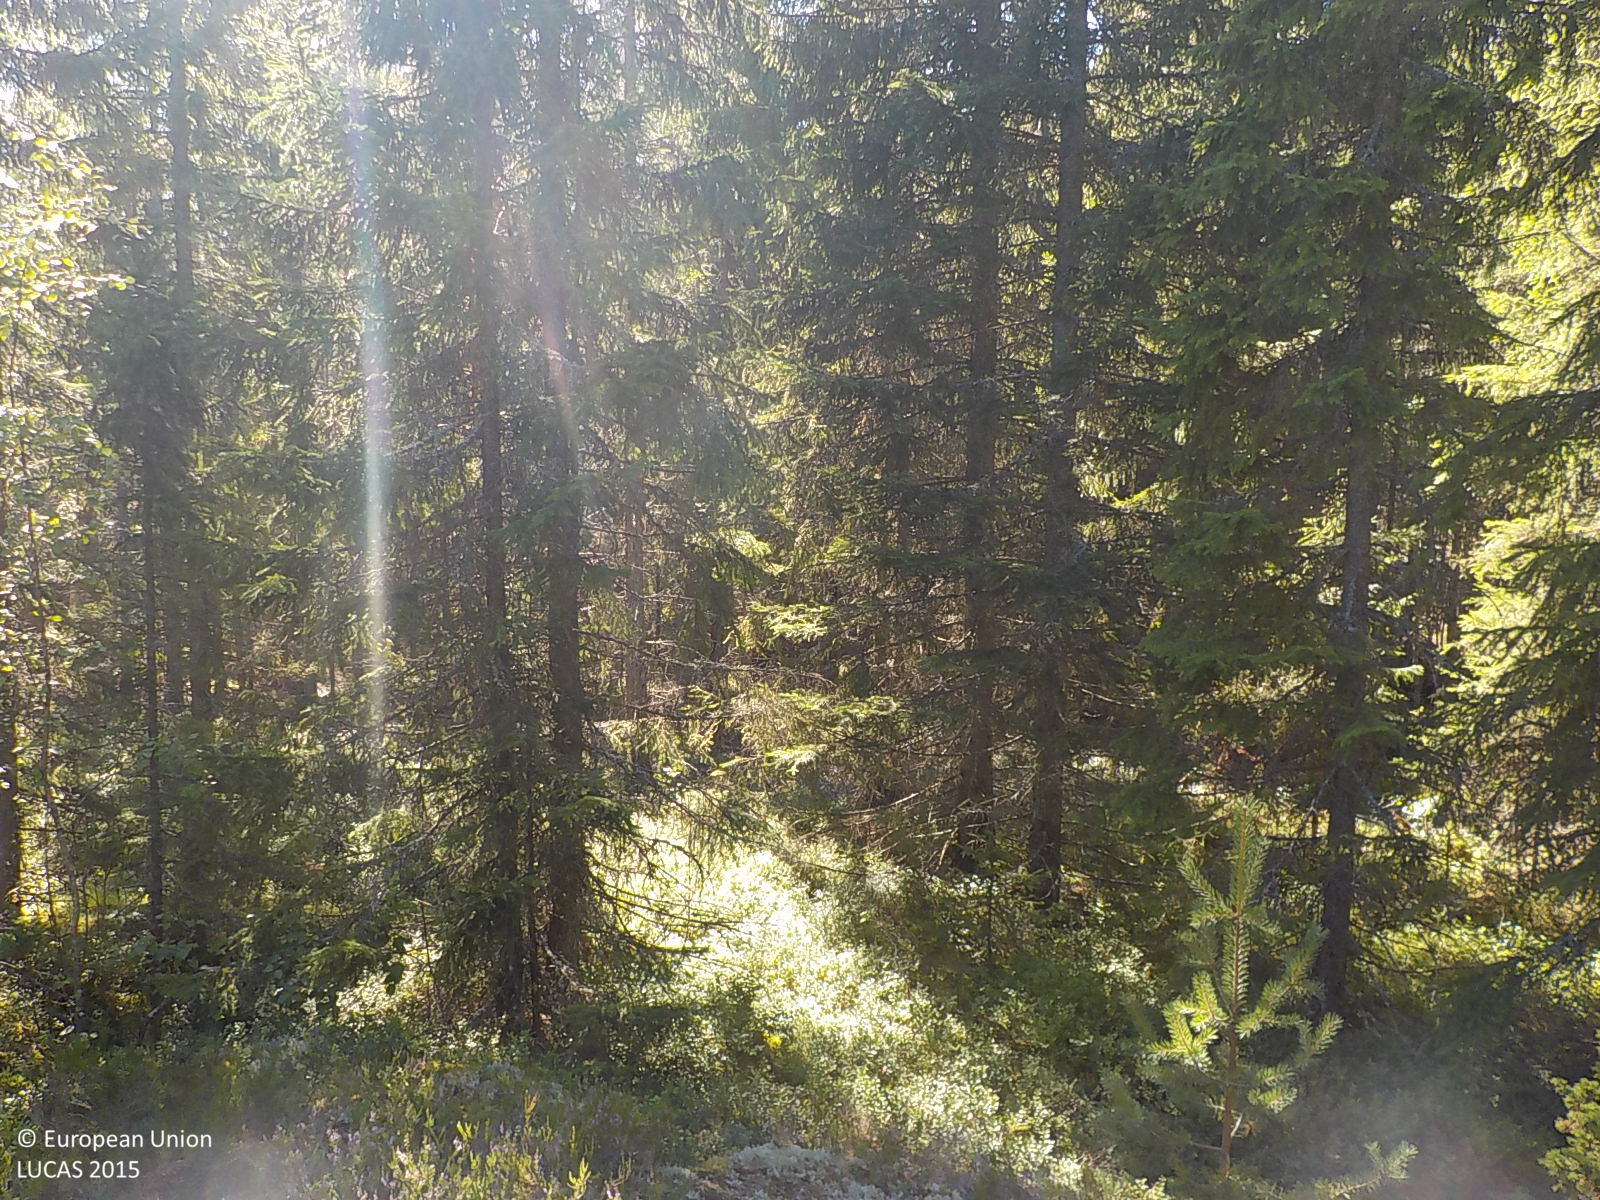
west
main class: Woodland
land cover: Spruce dominated mixed woodland
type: boreal forest
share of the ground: > 75 %
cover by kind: coniferous forest trees 60 %, broadleaved forest trees 20 %, herbaceous plants 20 %
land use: Forestry
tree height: > 5 m
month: August
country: SE
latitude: 63.3408
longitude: 18.7077
